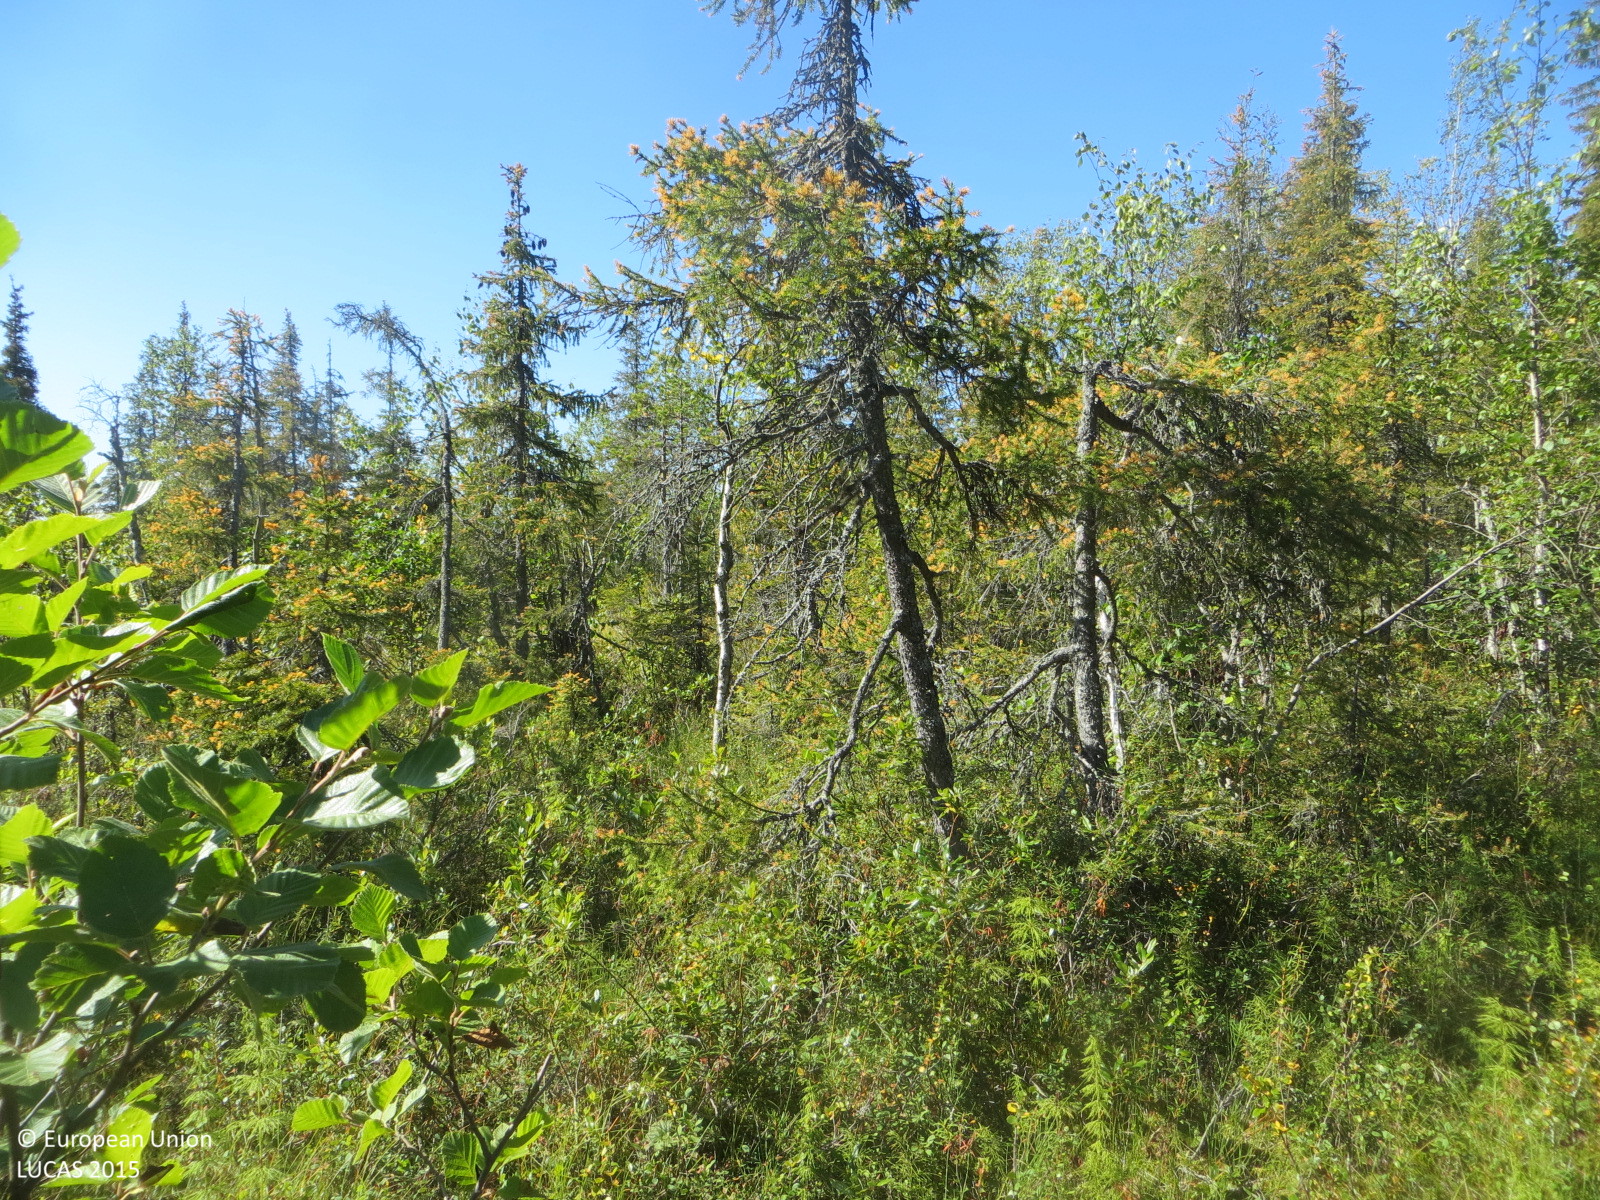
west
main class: Woodland
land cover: Spruce dominated mixed woodland
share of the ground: 50 - 75 %
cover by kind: shrubs 50 %, coniferous forest trees 25 %, broadleaved forest trees 25 %
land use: Forestry
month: August
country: FI
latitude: 67.1733
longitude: 23.9087
